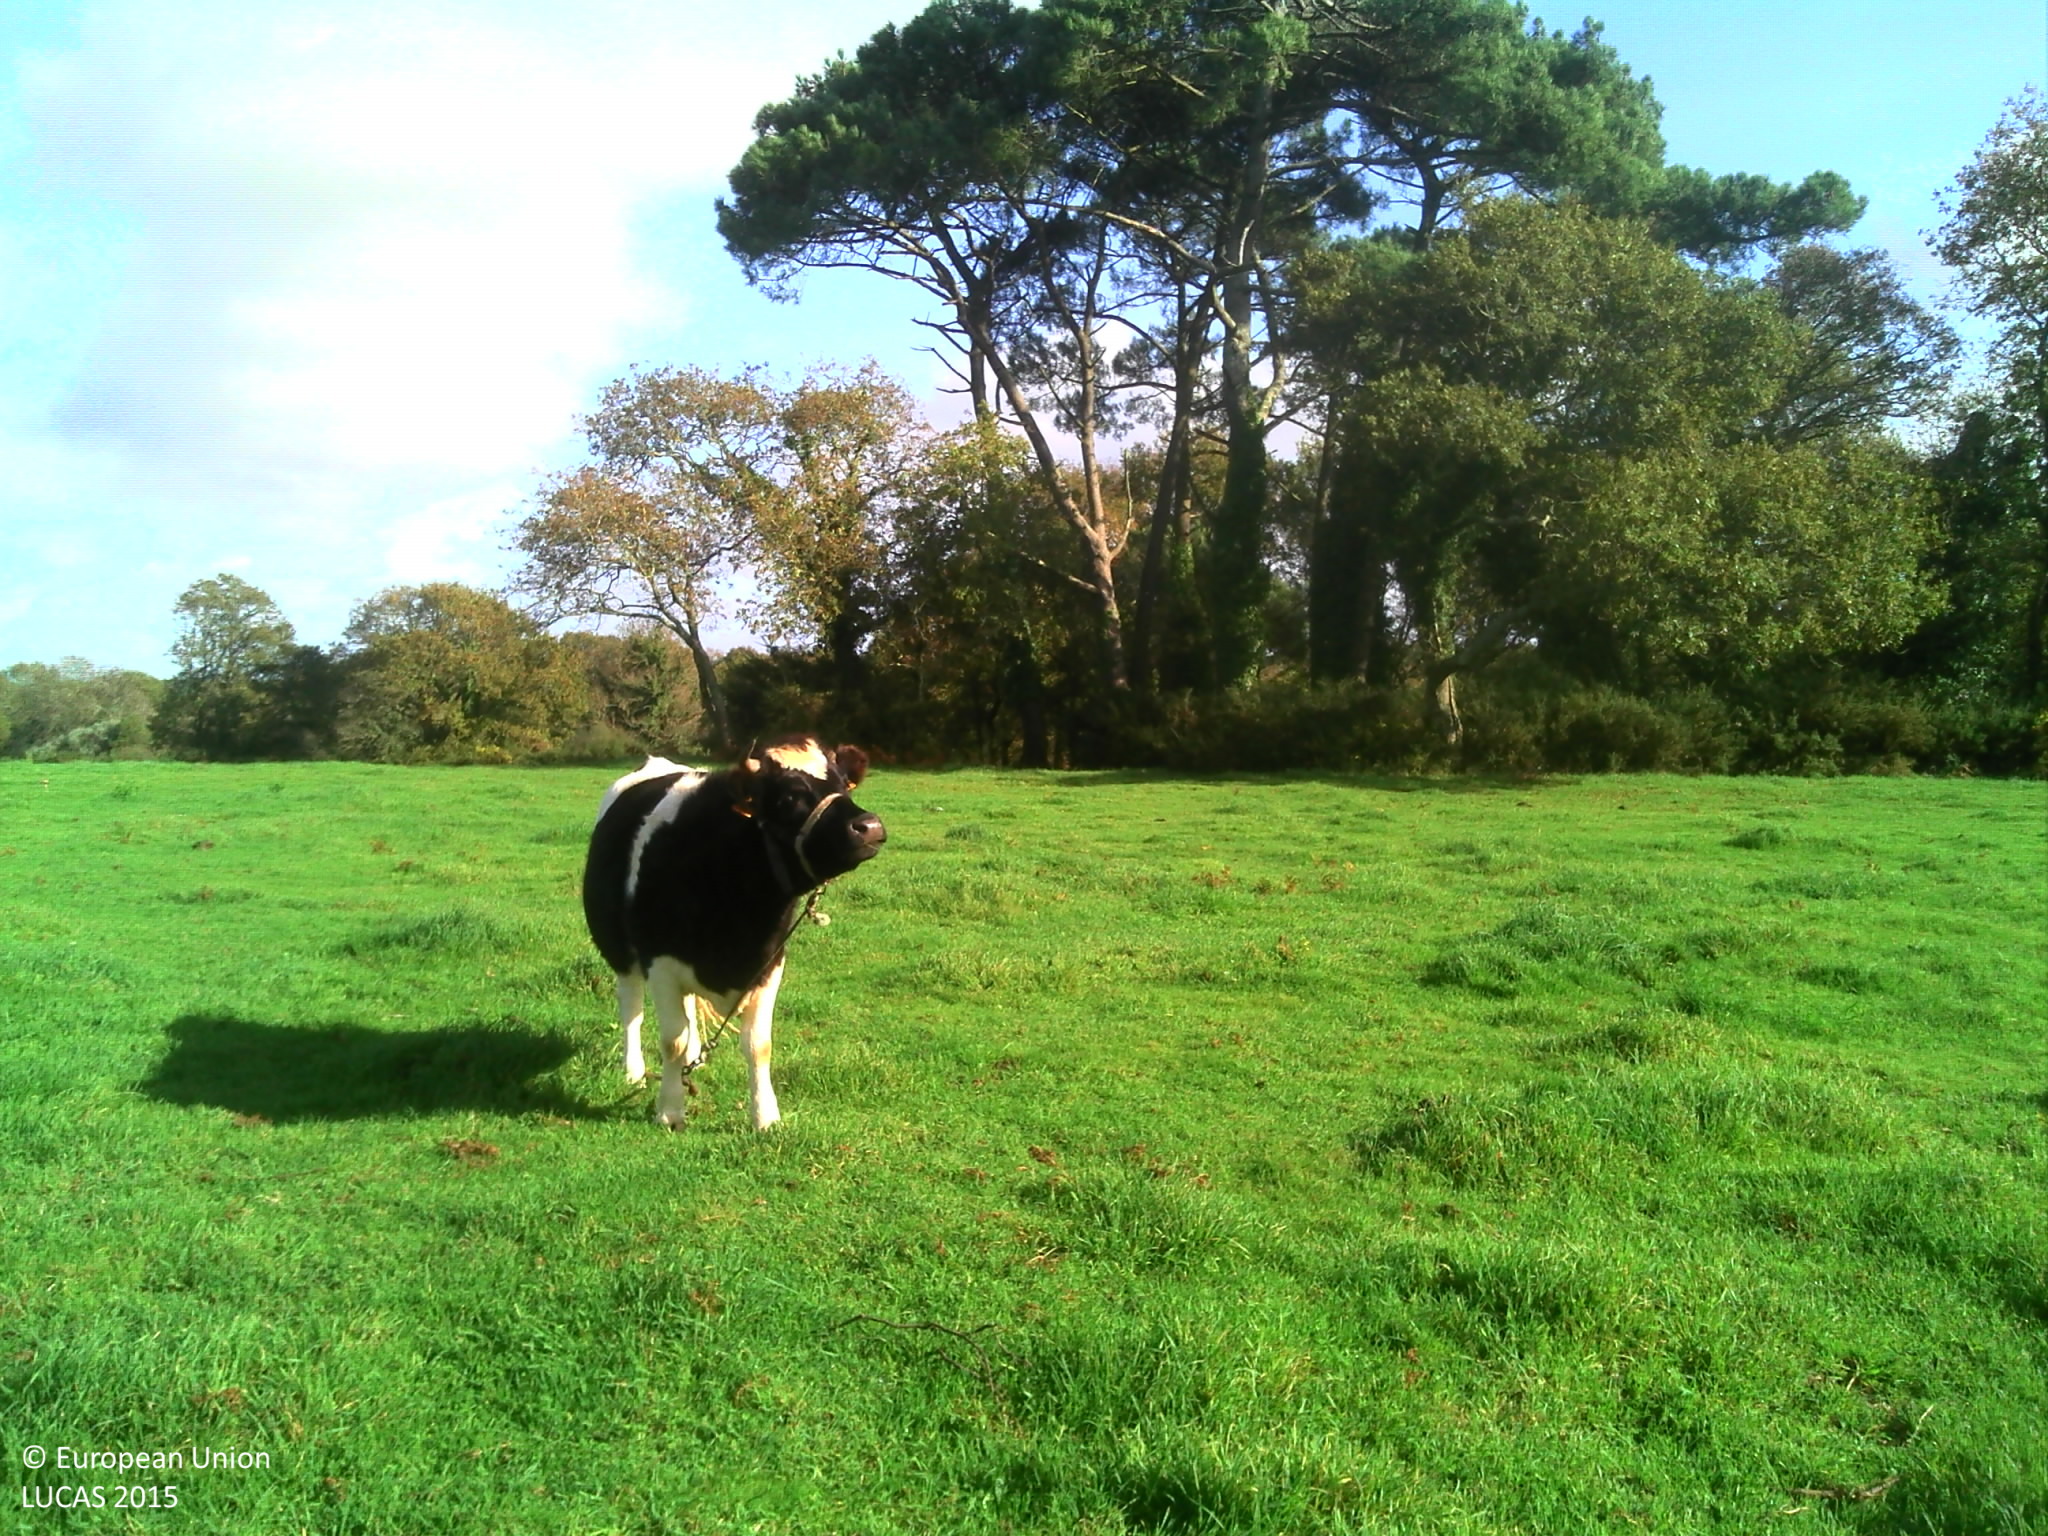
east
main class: Grassland
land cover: Grassland without tree/shrub cover
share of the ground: > 75 %
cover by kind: herbaceous plants 100 %
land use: Agriculture (excluding fallow land and kitchen gardens)
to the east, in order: Grassland without tree/shrub cover; Fences; Pine dominated mixed woodland; Tracks; Fences; Grassland without tree/shrub cover; Fences; Broadleaved woodland
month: November
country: FR
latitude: 47.6240
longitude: -3.0673
